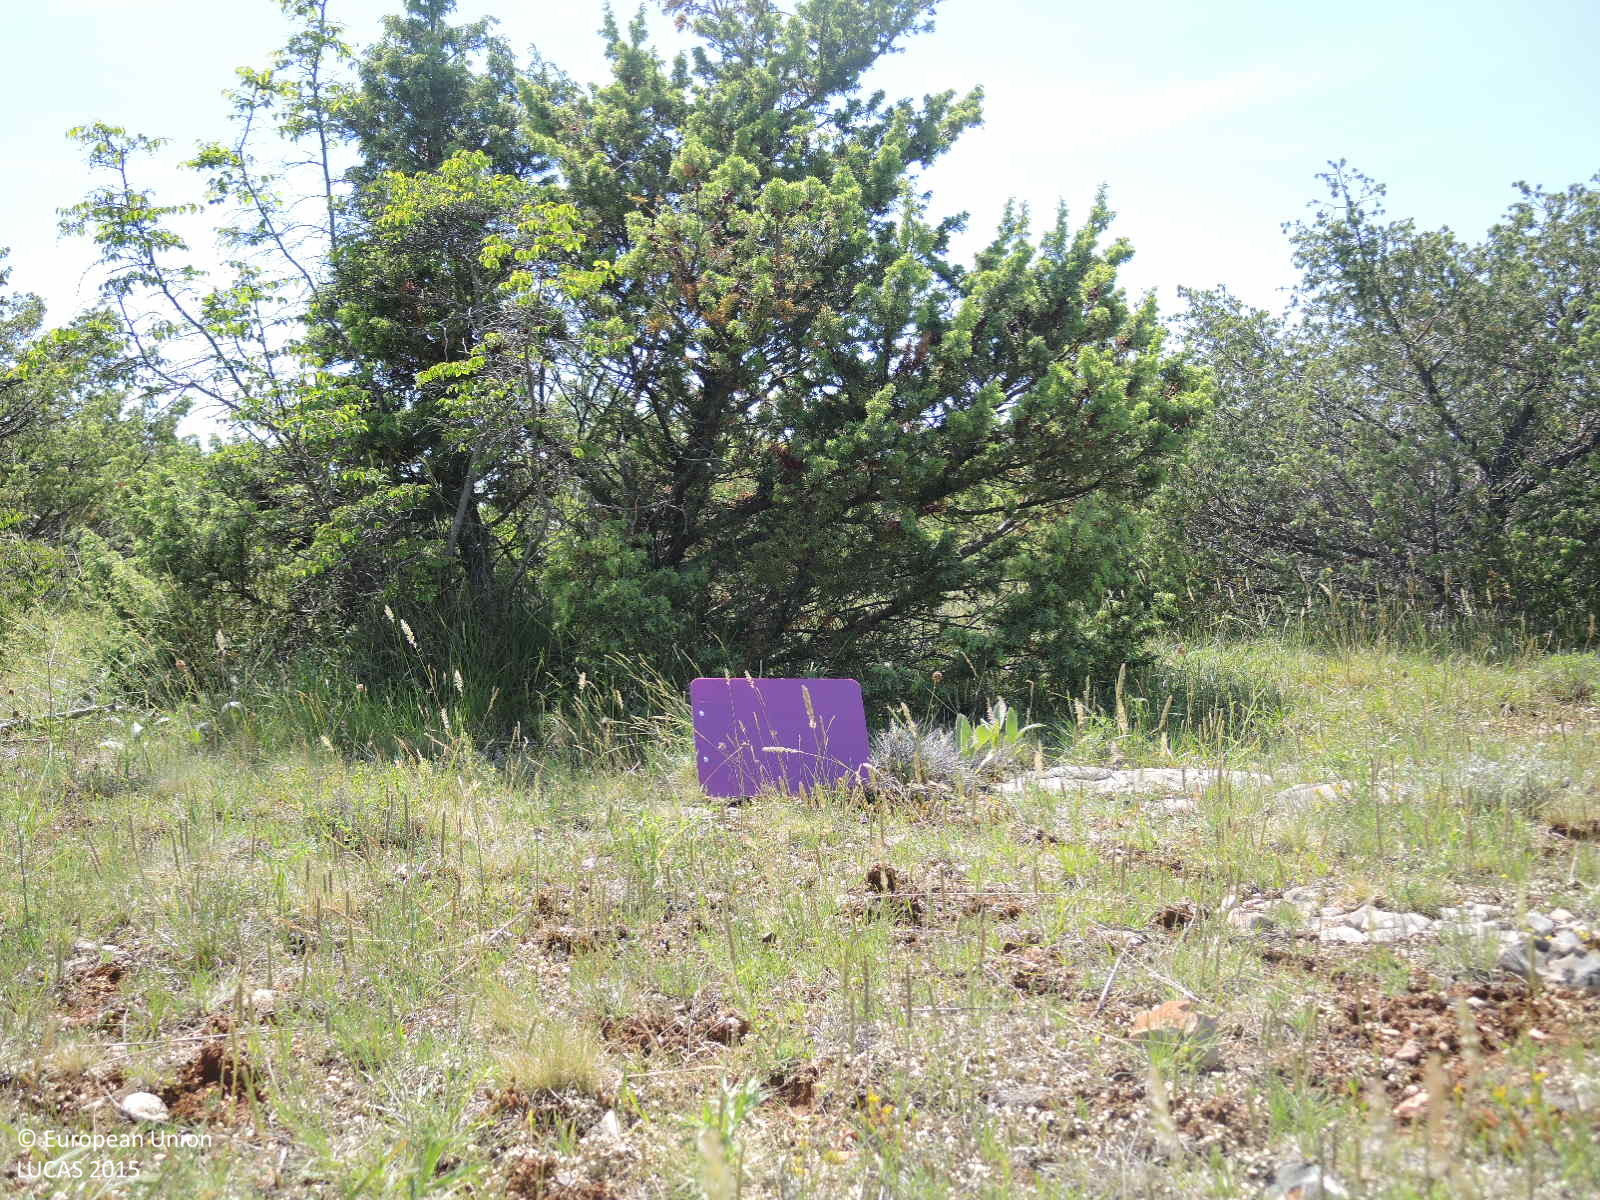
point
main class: Shrubland
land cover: Shrubland with sparse tree cover
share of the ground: 25 - 50 %
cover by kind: shrubs 45 %, herbaceous plants 45 %, coniferous forest trees 5 %, consolidated bare surface 5 %
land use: Semi-natural and natural areas not in use
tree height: < 5 m
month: May
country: HR
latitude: 43.9276
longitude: 15.9332
